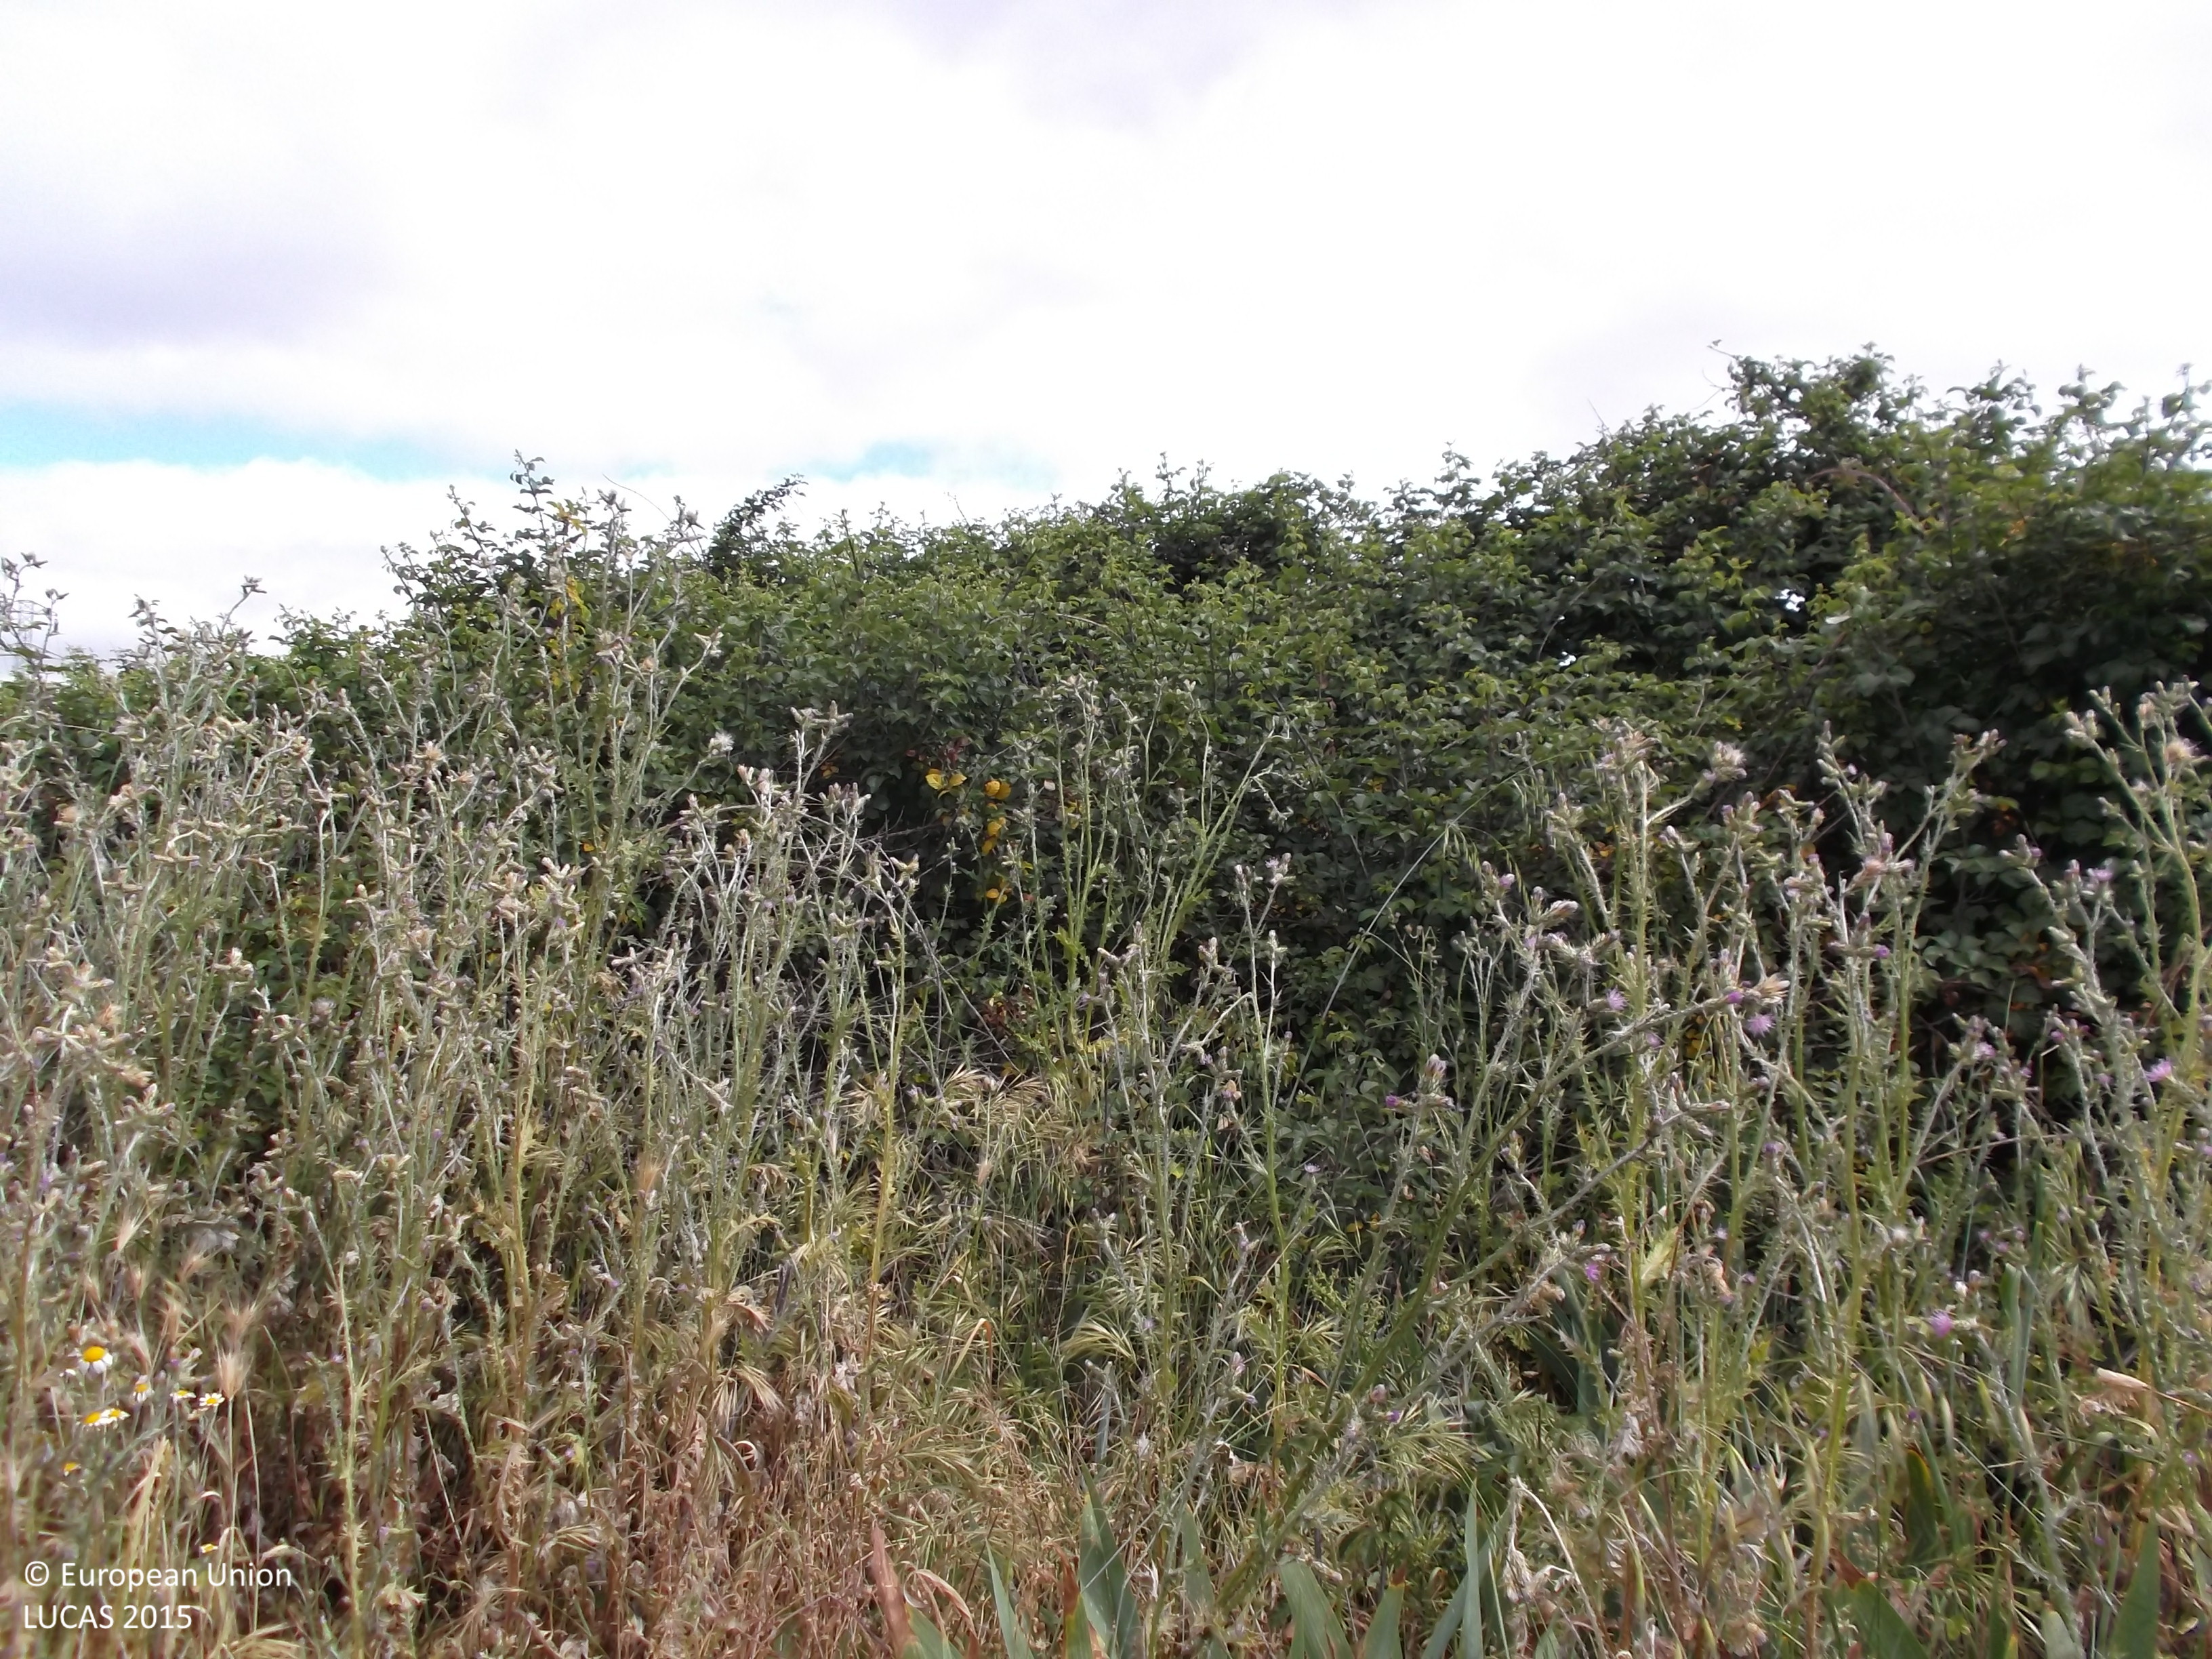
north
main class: Shrubland
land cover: Shrubland without tree cover
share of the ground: > 75 %
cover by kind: shrubs 100 %
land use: Abandoned areas
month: May
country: ES
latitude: 42.4503
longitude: -2.4344
